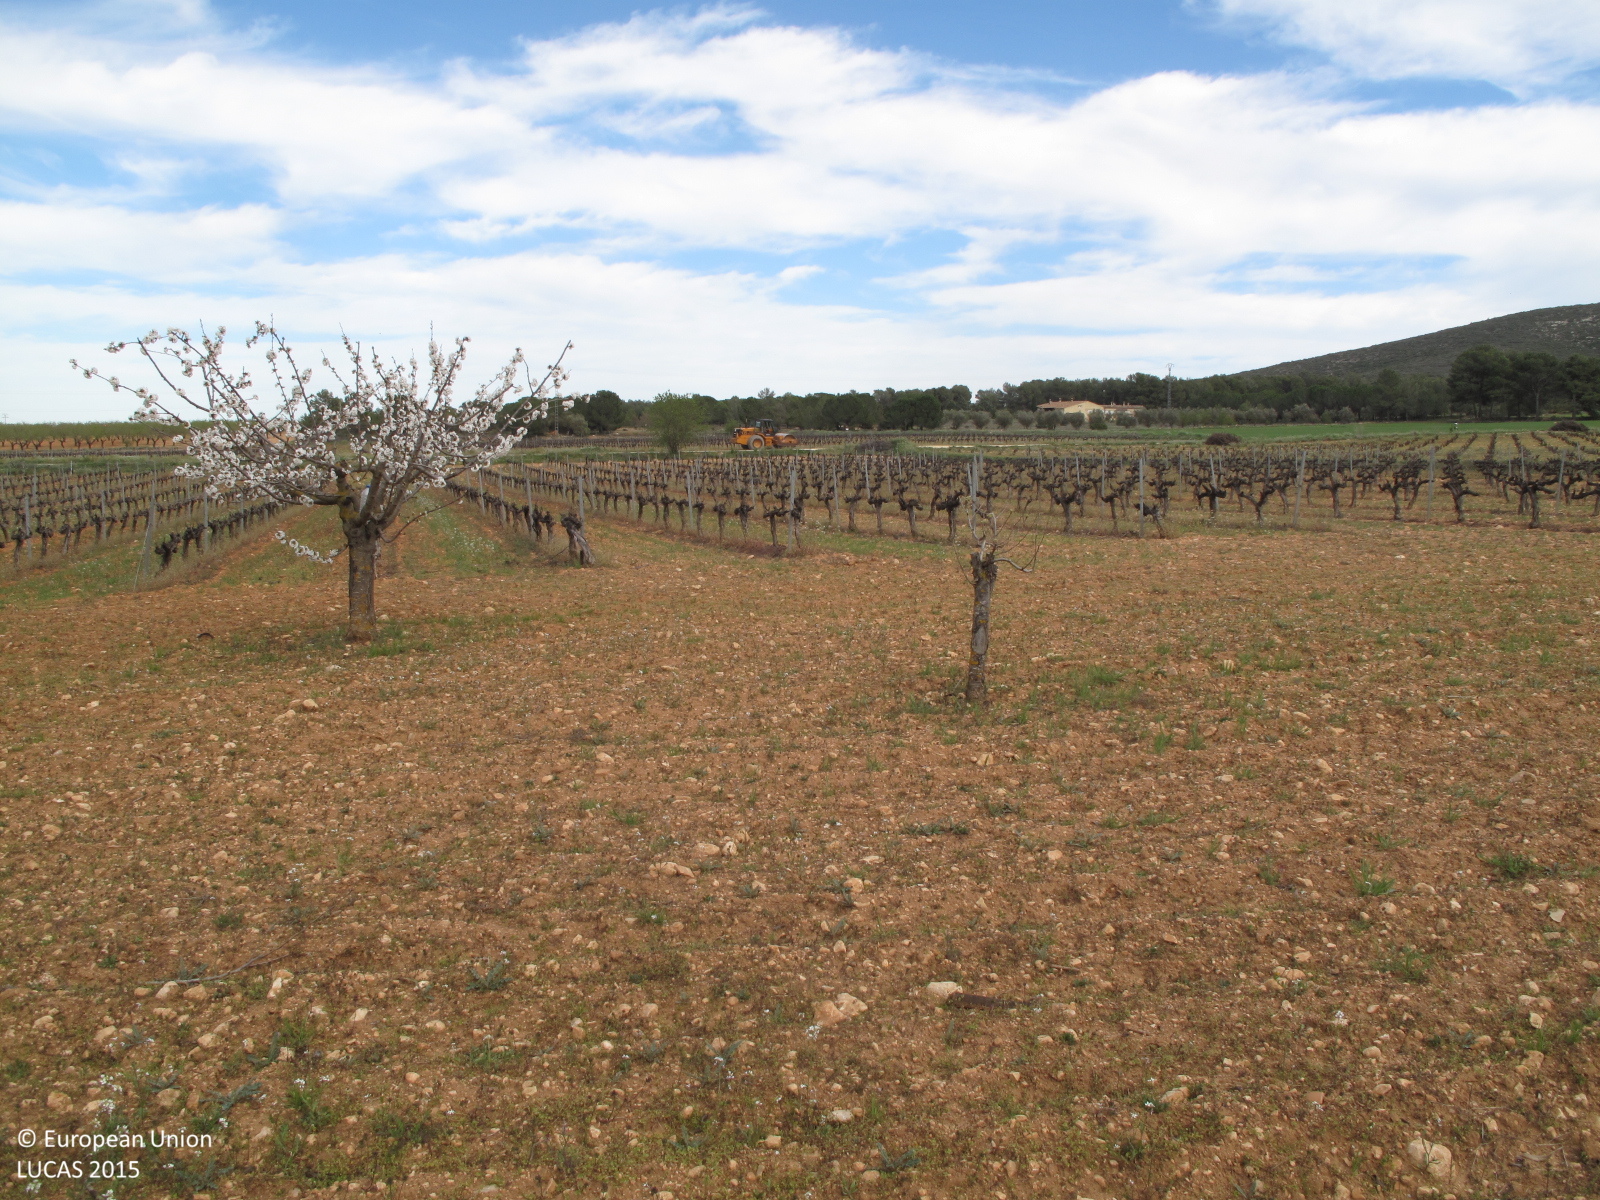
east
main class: Cropland
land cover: Cherry fruit
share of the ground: 10 - 25 %
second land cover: Other fruit trees and berries
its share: < 10 %
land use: Agriculture (excluding fallow land and kitchen gardens)
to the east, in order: Cherry fruit; Other fruit trees and berries; Vineyards; Grass margins; Tracks; Grass margins; Vineyards
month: March
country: ES
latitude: 38.7802
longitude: -0.7544
